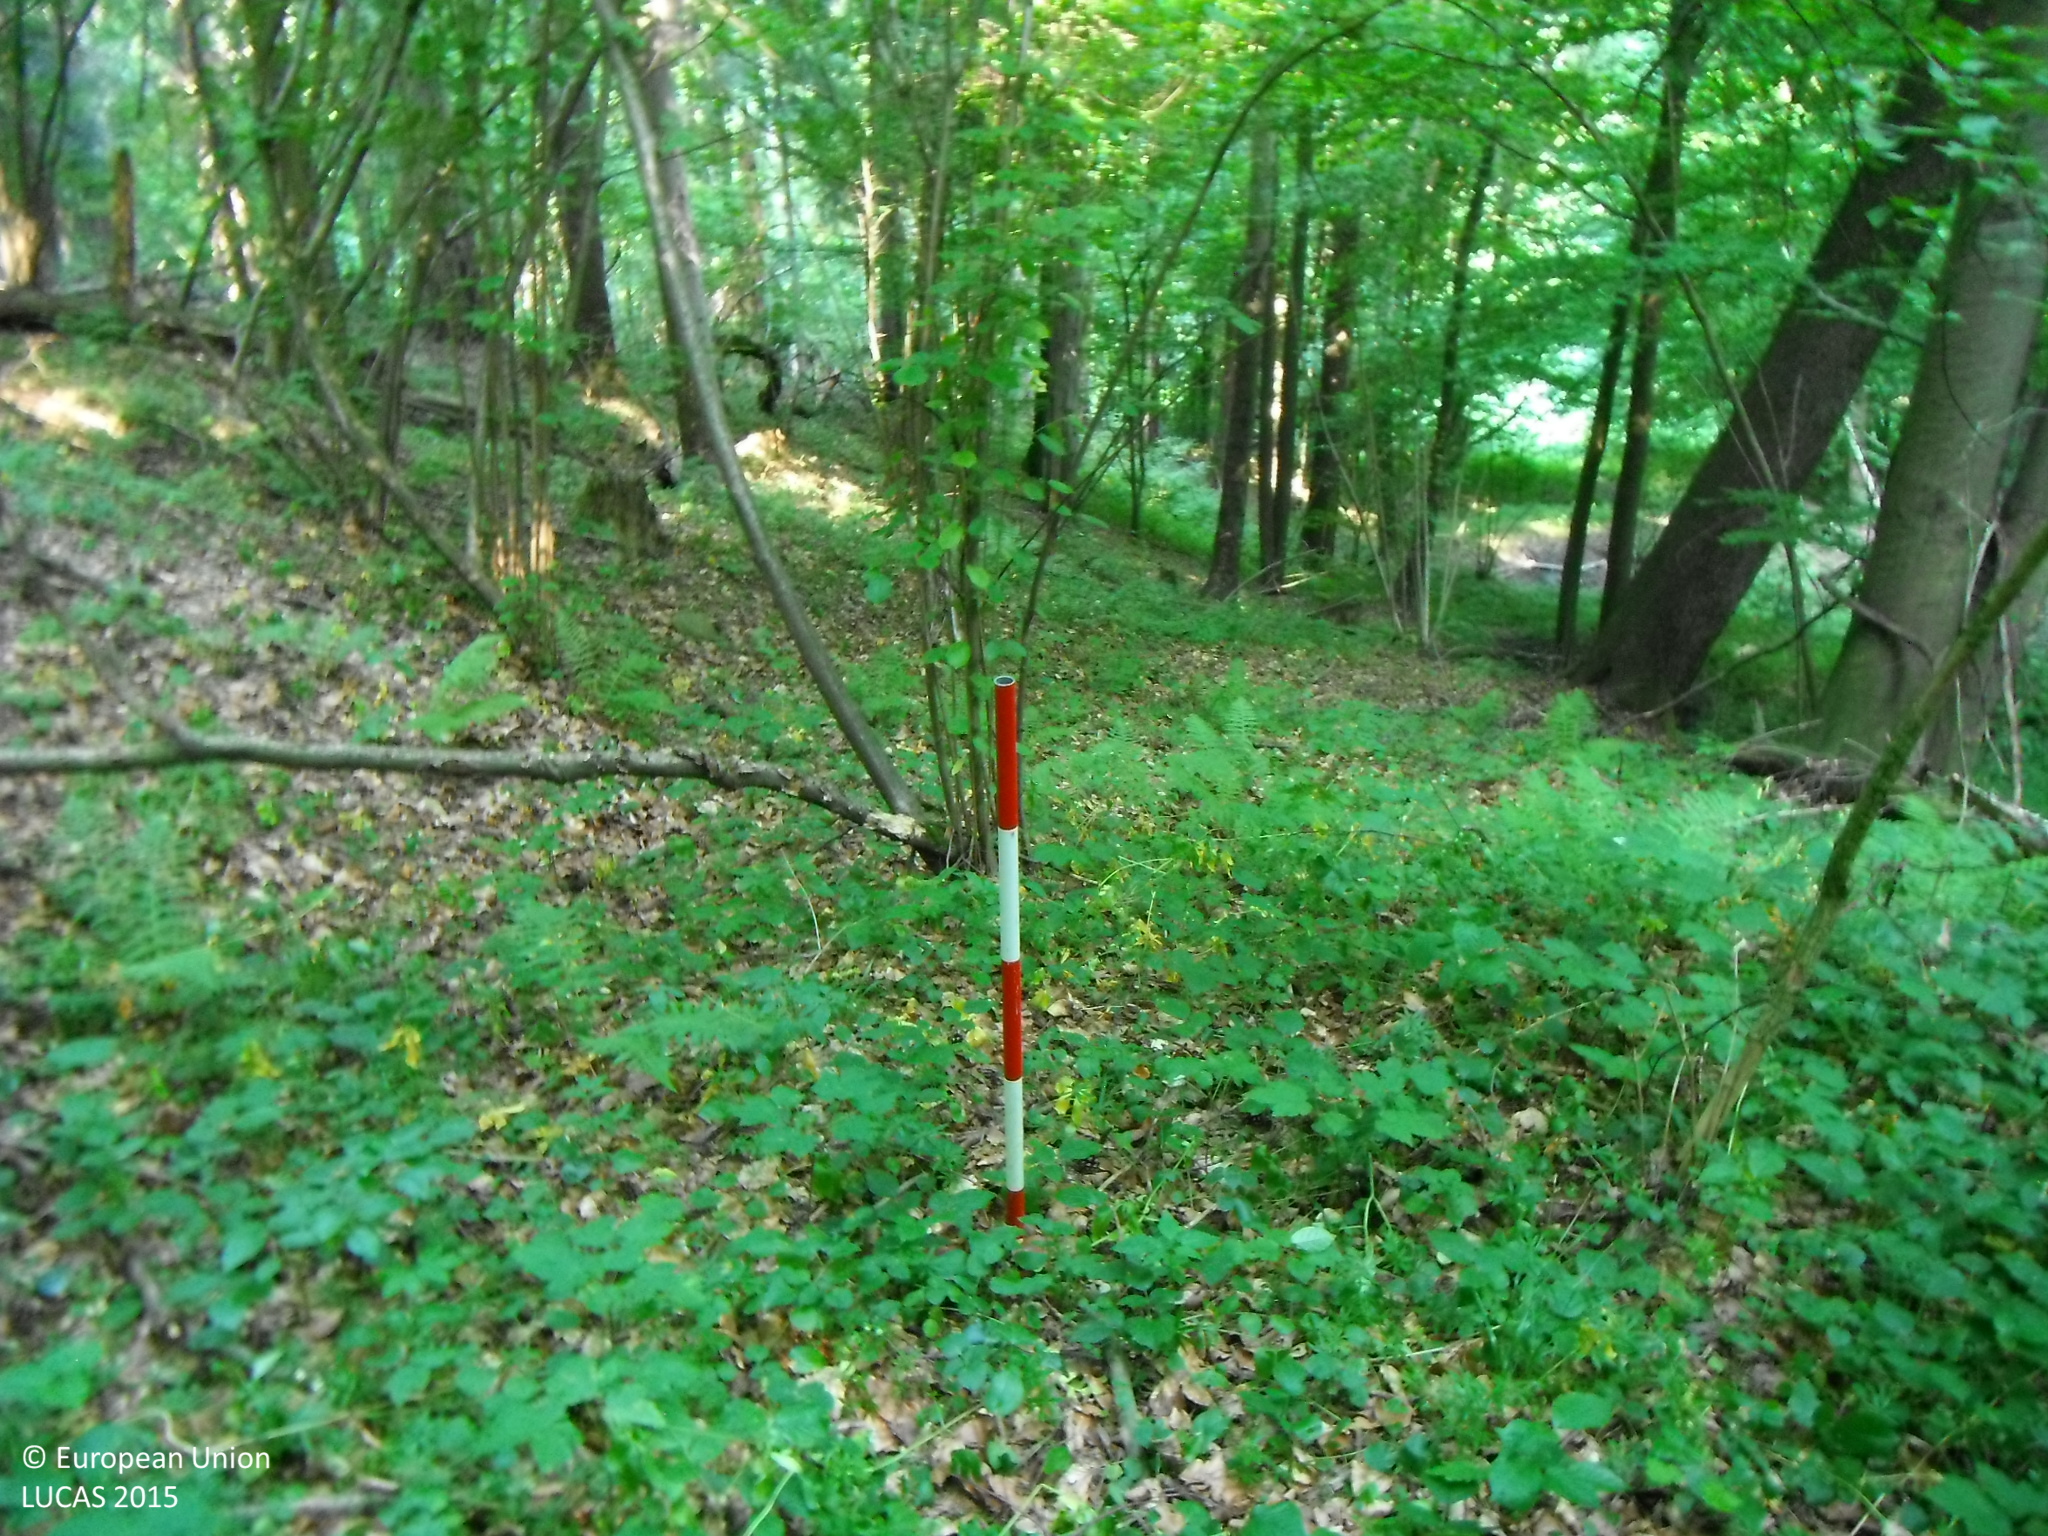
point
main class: Woodland
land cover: Other mixed woodland
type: hemiboreal forest and nemoral coniferous forest and mixed broadleaved-coniferous forest
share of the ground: > 75 %
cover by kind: coniferous forest trees 60 %, broadleaved forest trees 30 %, herbaceous plants 10 %
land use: Forestry
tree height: > 5 m
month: July
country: SK
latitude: 49.3188
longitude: 21.2300
